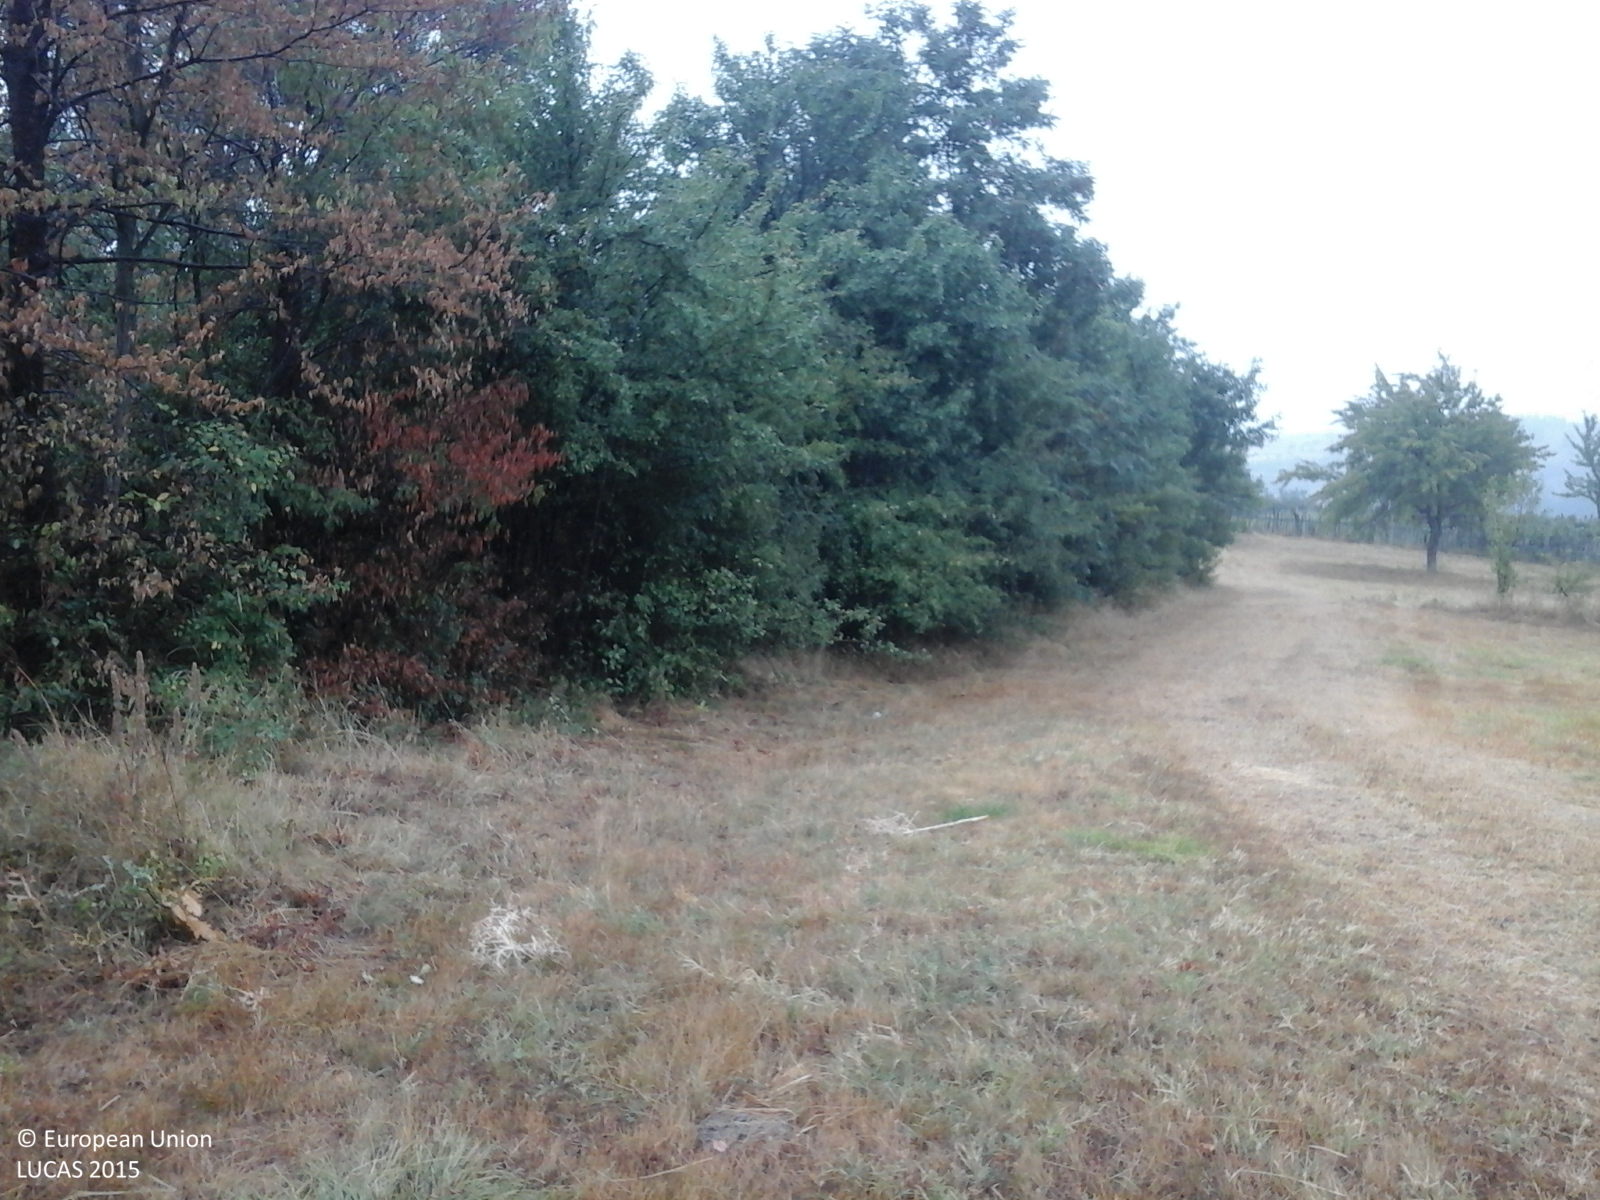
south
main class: Grassland
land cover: Grassland without tree/shrub cover
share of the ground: > 75 %
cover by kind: herbaceous plants 100 %
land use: Agriculture (excluding fallow land and kitchen gardens)
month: August
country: RO
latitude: 44.7891
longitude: 22.6955
